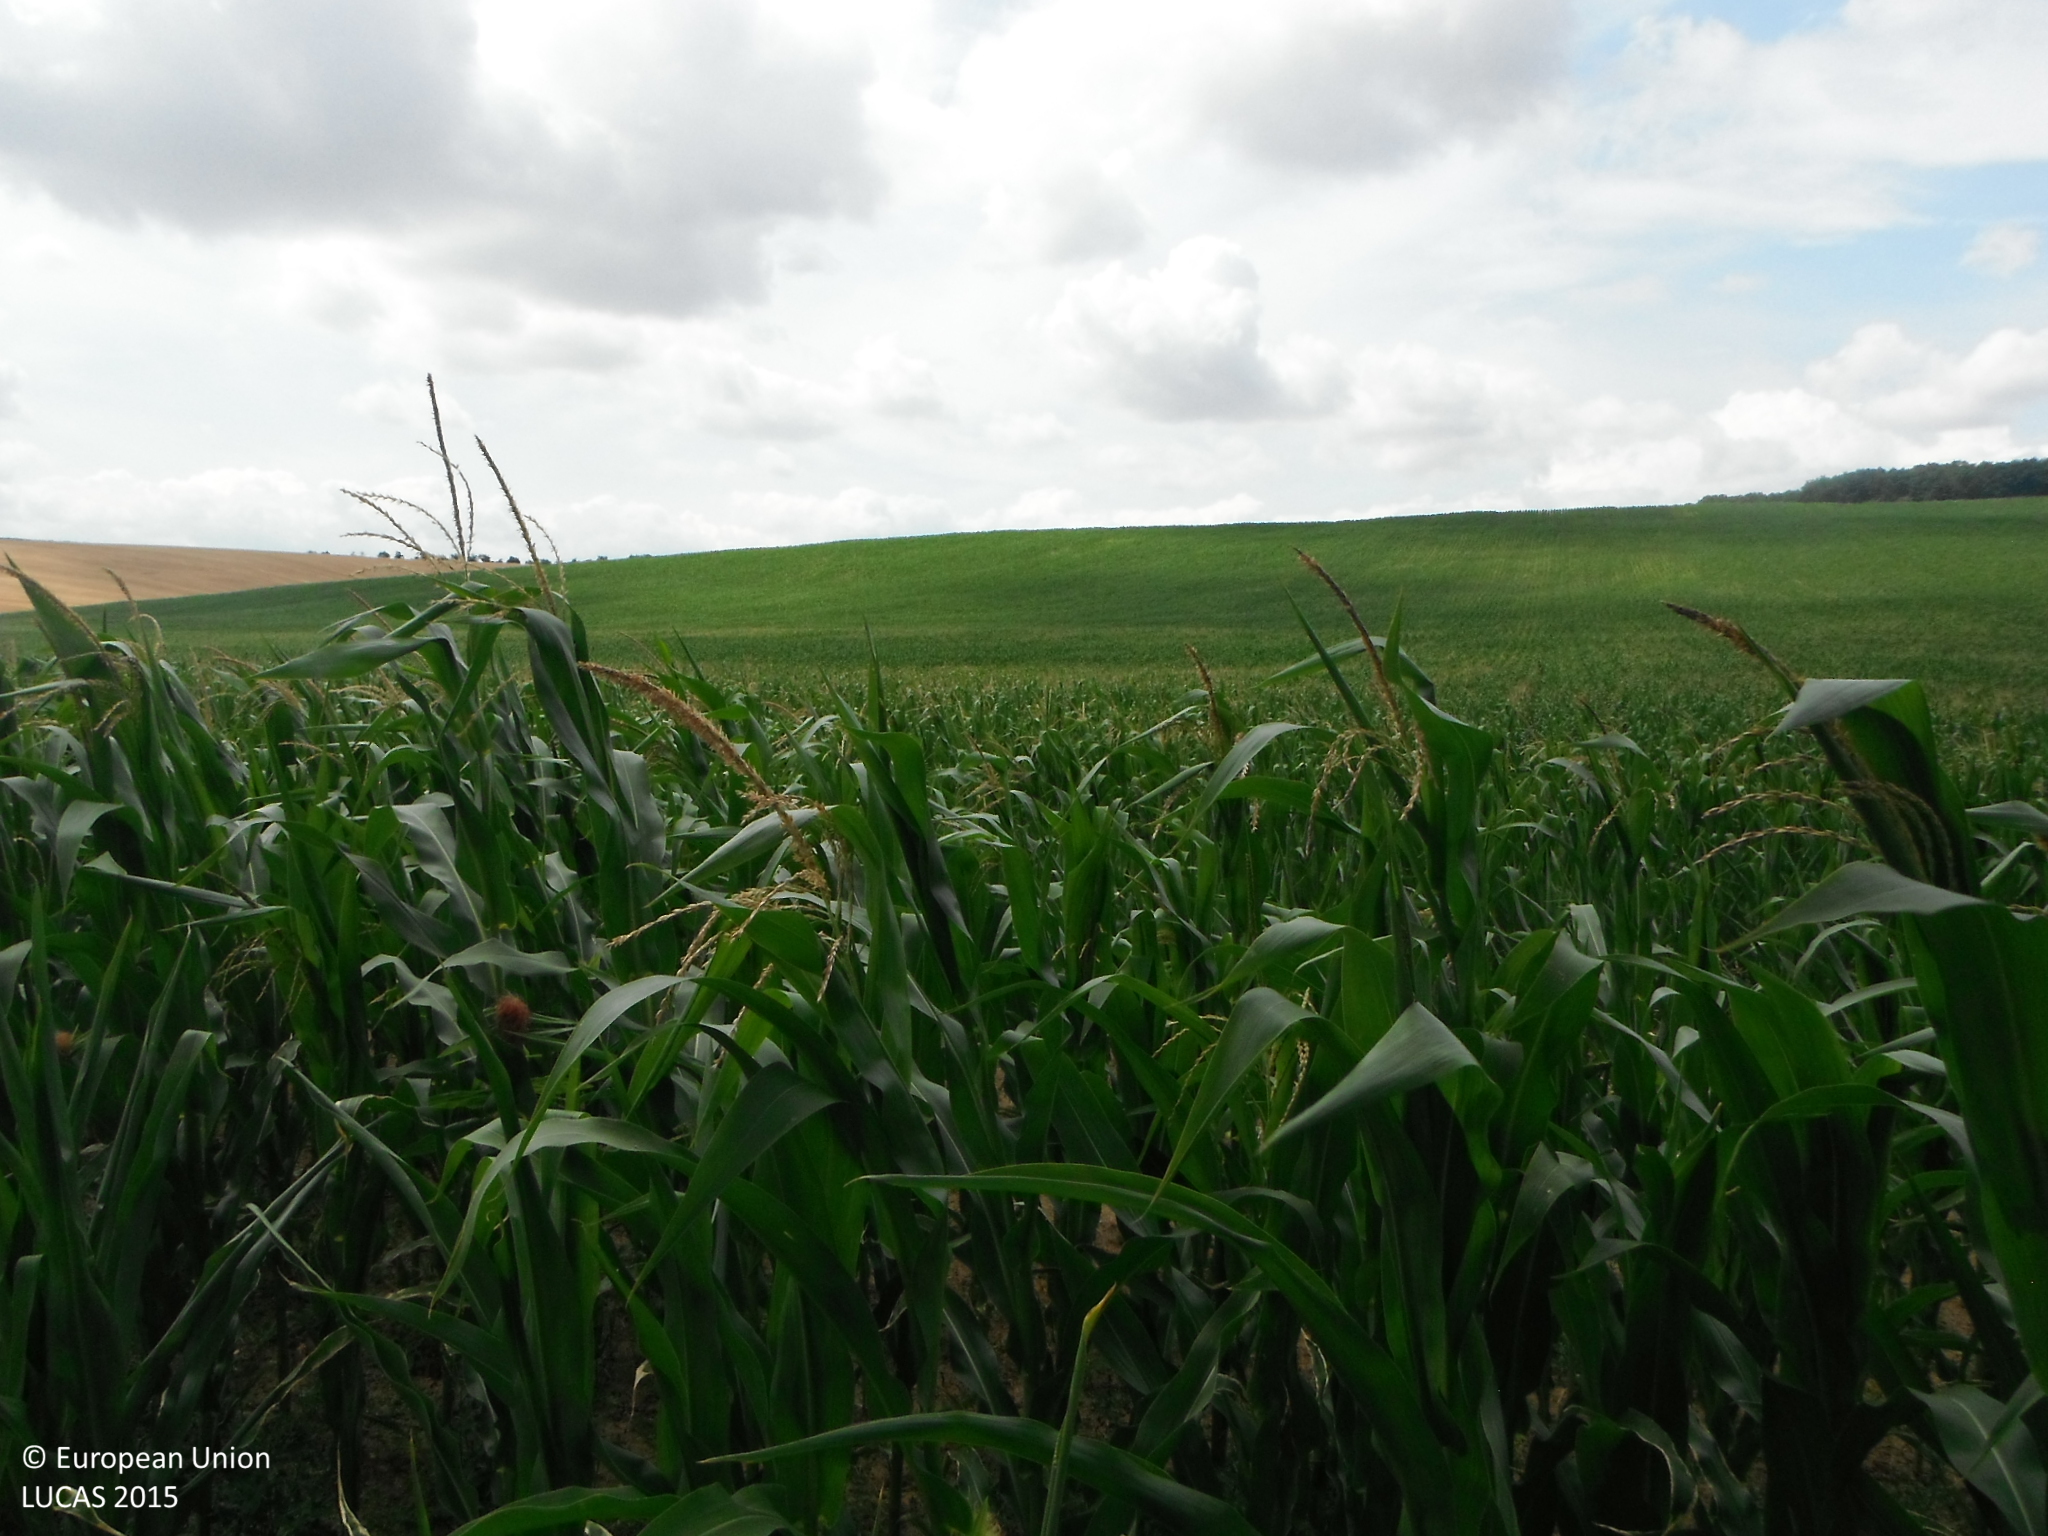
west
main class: Cropland
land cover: Maize
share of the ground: > 75 %
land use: Agriculture (excluding fallow land and kitchen gardens)
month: July
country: SK
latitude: 48.5201
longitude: 18.1242
